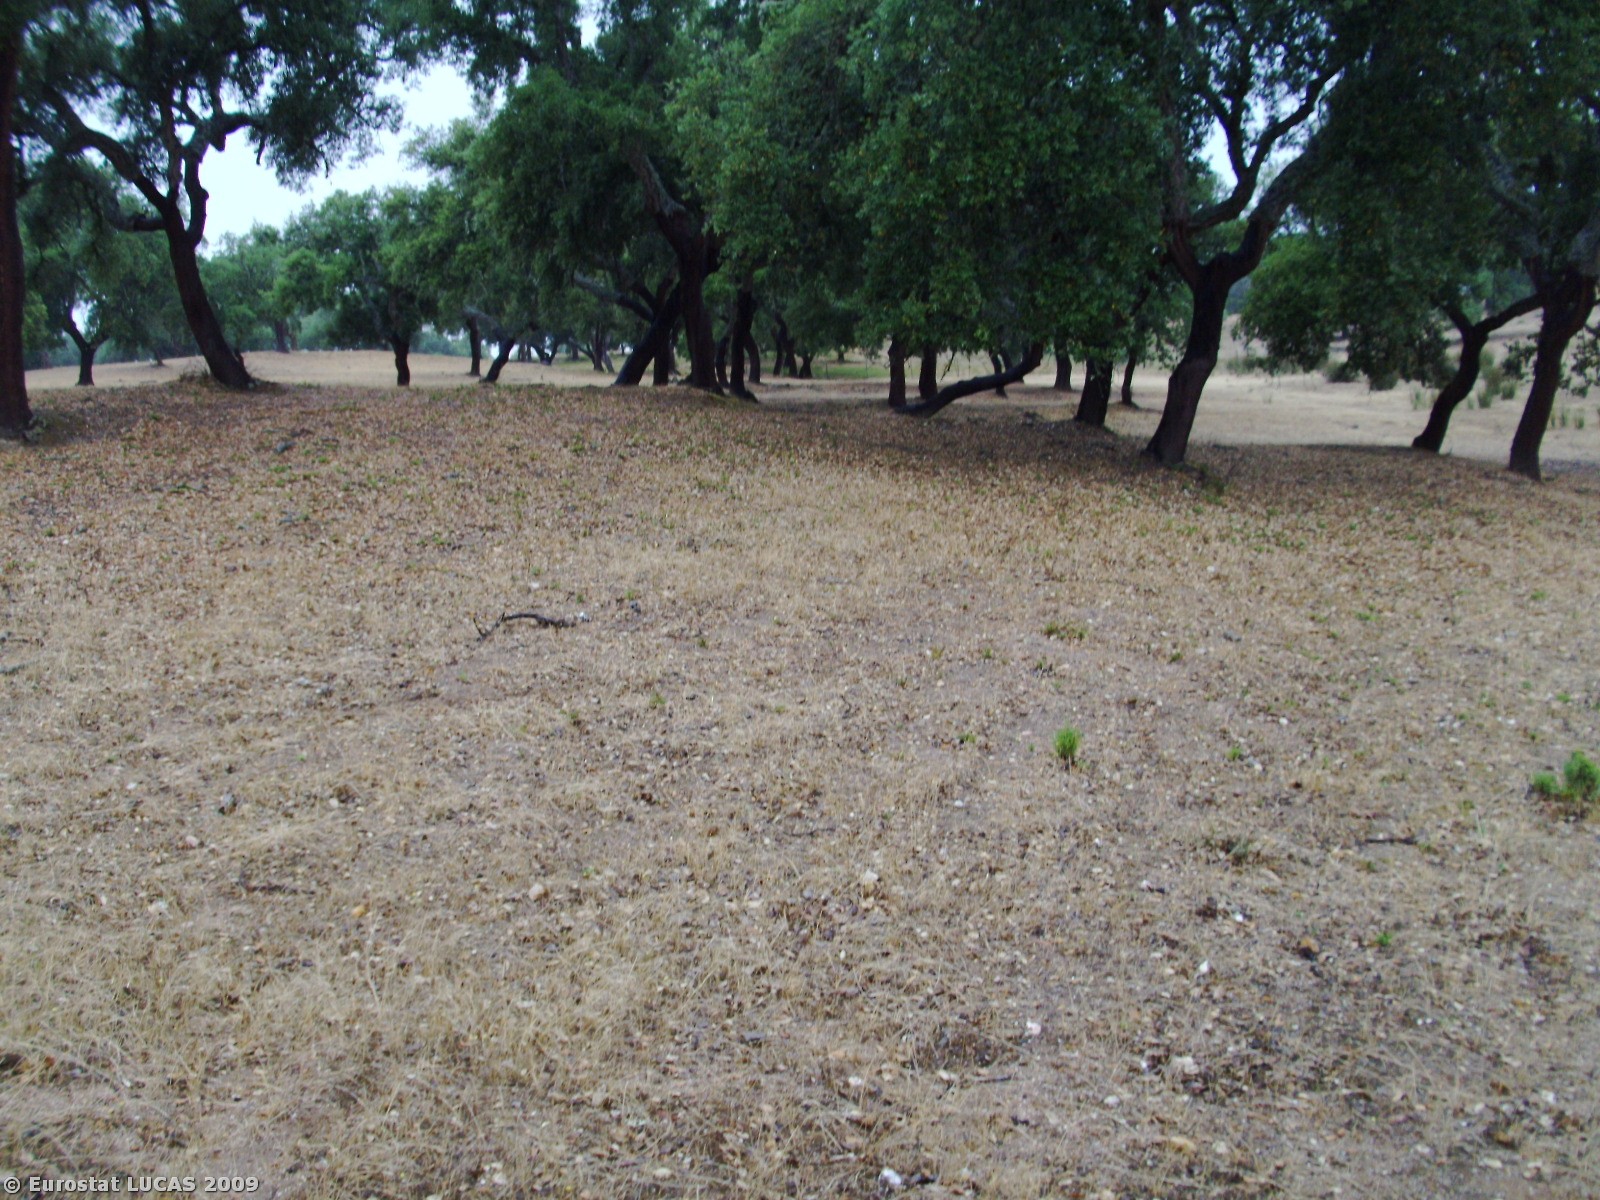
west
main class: Woodland
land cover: Broadleaved woodland
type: broadleaved evergreen forest
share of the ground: 50 - 75 %
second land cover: Bare land
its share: 25 - 50 %
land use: Forestry
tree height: > 5 m
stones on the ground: 25 - 50 %
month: June
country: PT
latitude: 39.7967
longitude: -7.2487
